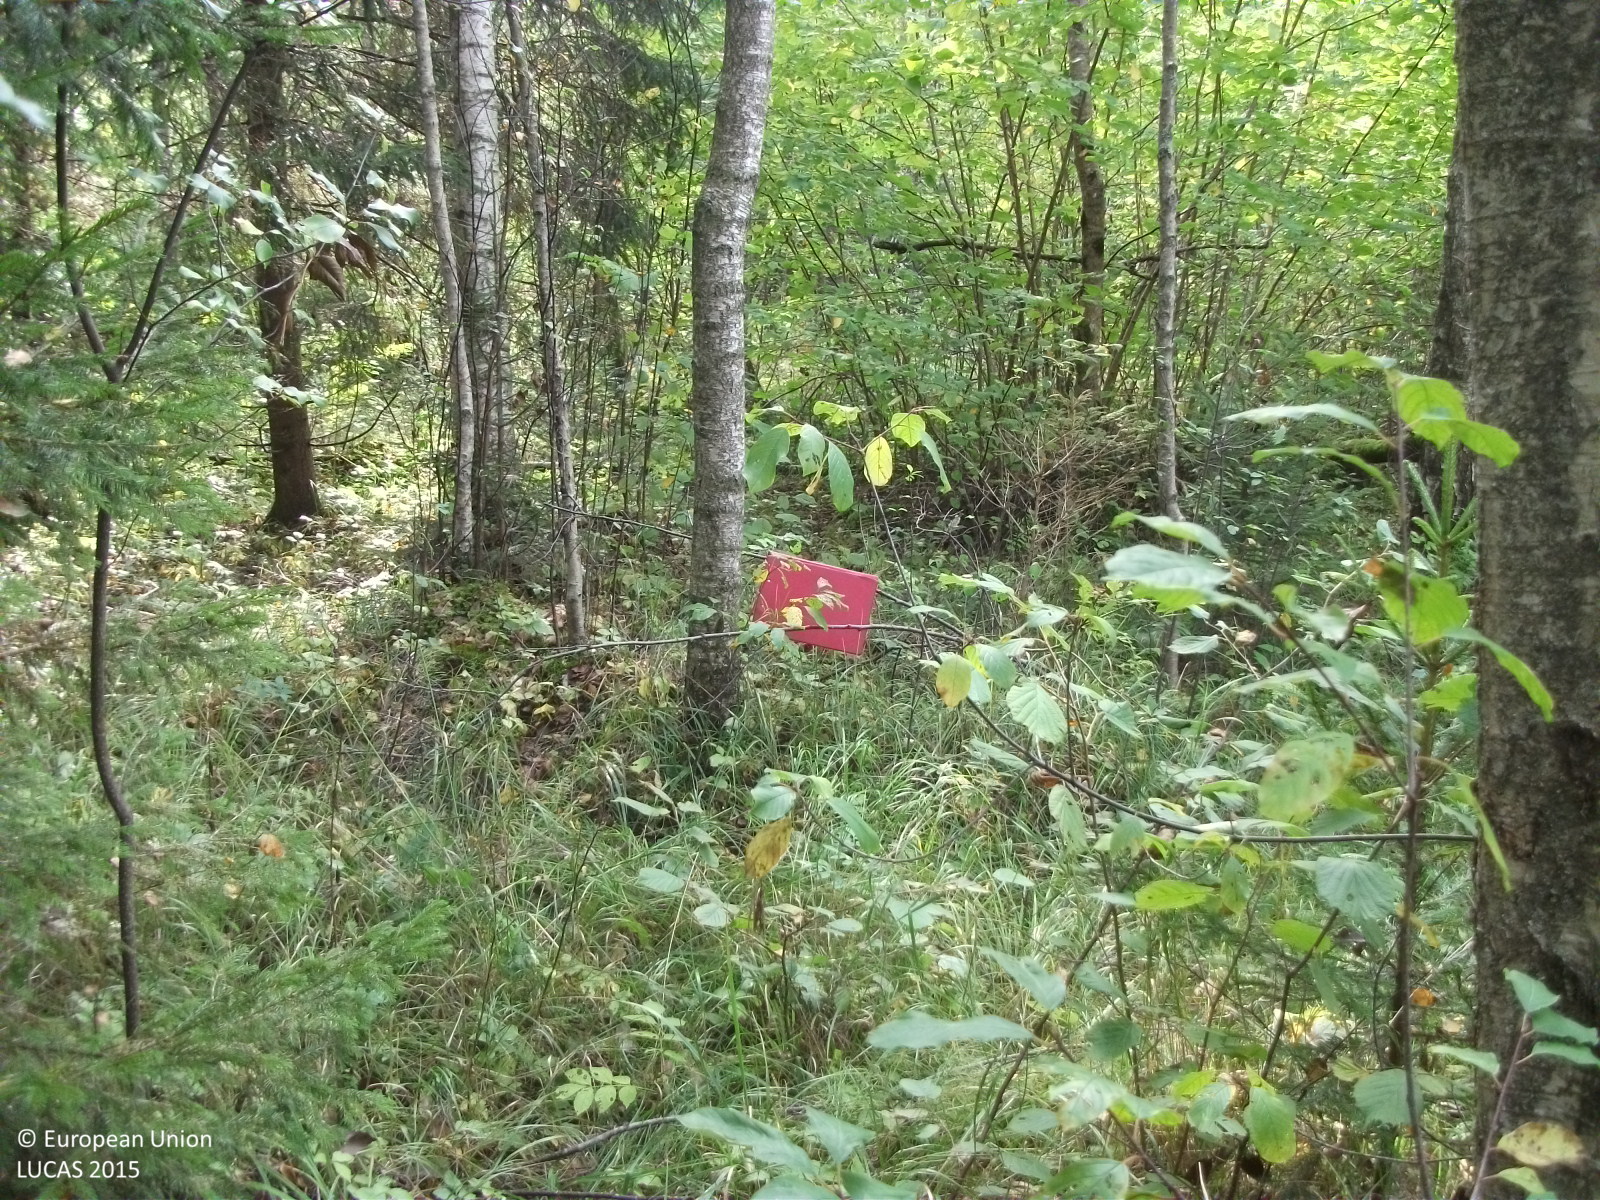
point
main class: Woodland
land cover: Spruce dominated mixed woodland
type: hemiboreal forest and nemoral coniferous forest and mixed broadleaved-coniferous forest
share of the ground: > 75 %
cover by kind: broadleaved forest trees 65 %, coniferous forest trees 25 %, shrubs 5 %, herbaceous plants 5 %
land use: Forestry
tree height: > 5 m
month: September
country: LV
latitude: 57.6416
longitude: 24.5484
